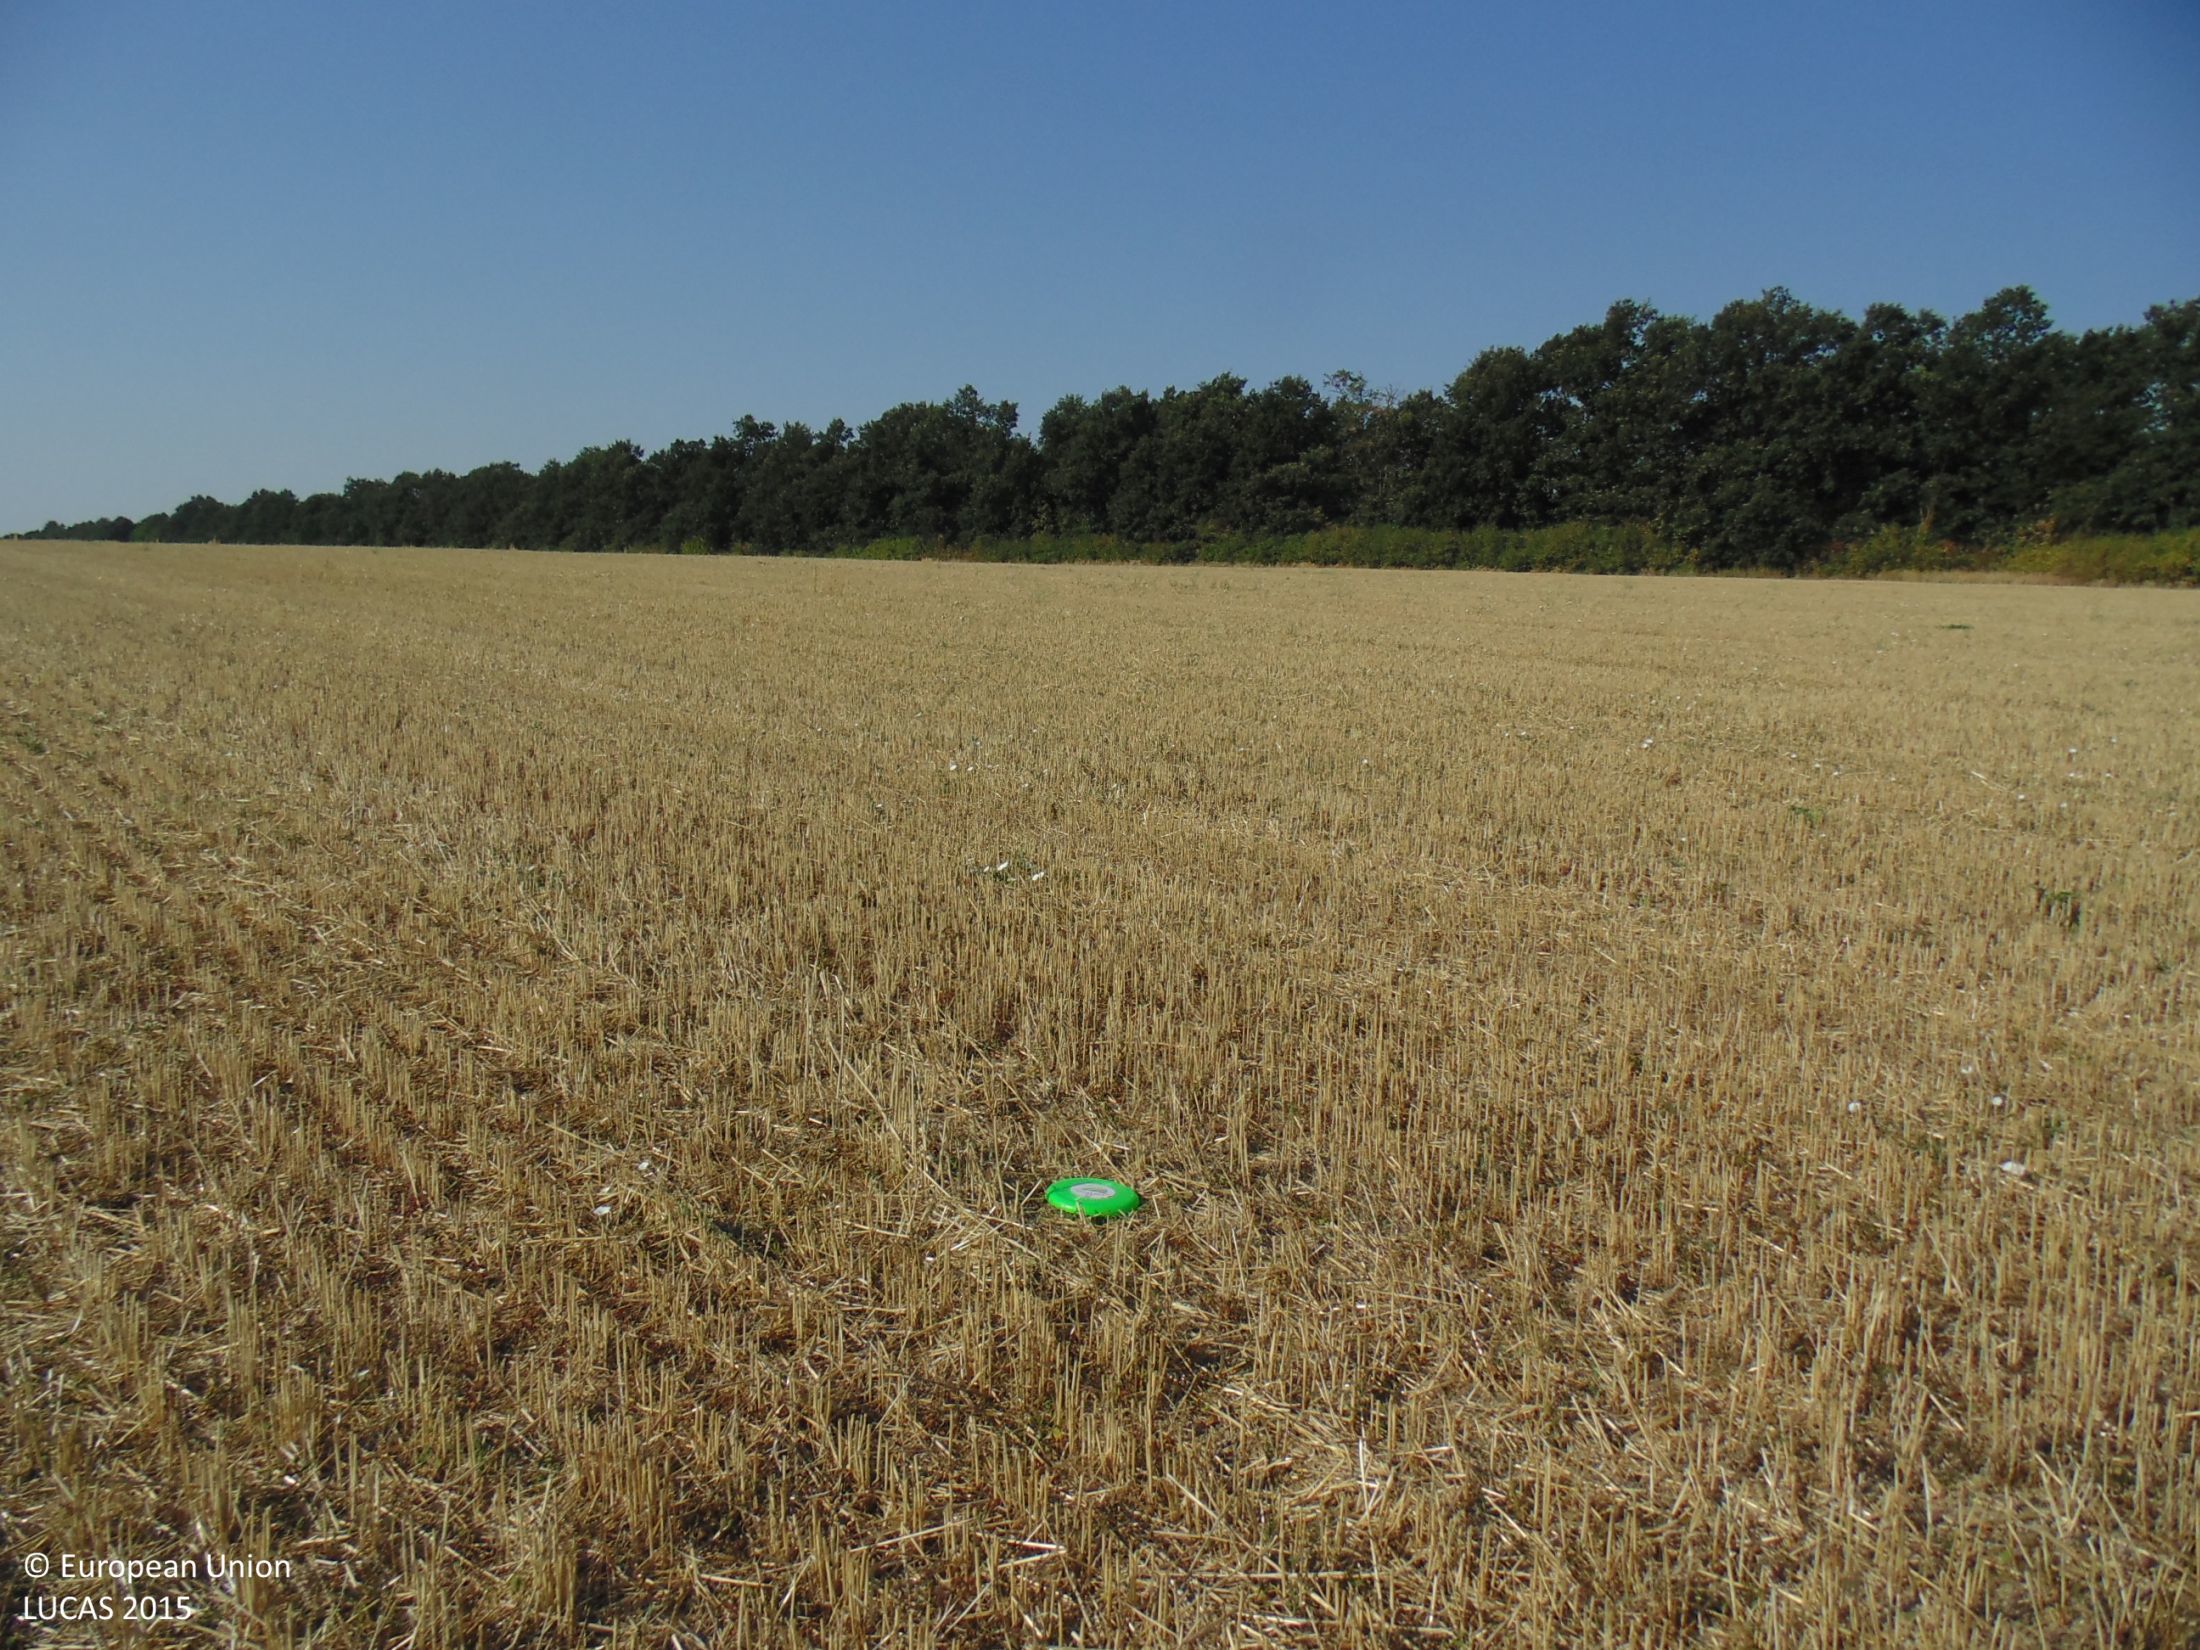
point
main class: Cropland
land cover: Common wheat
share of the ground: 50 - 75 %
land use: Agriculture (excluding fallow land and kitchen gardens)
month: August
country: BG
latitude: 44.0029
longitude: 27.4332
